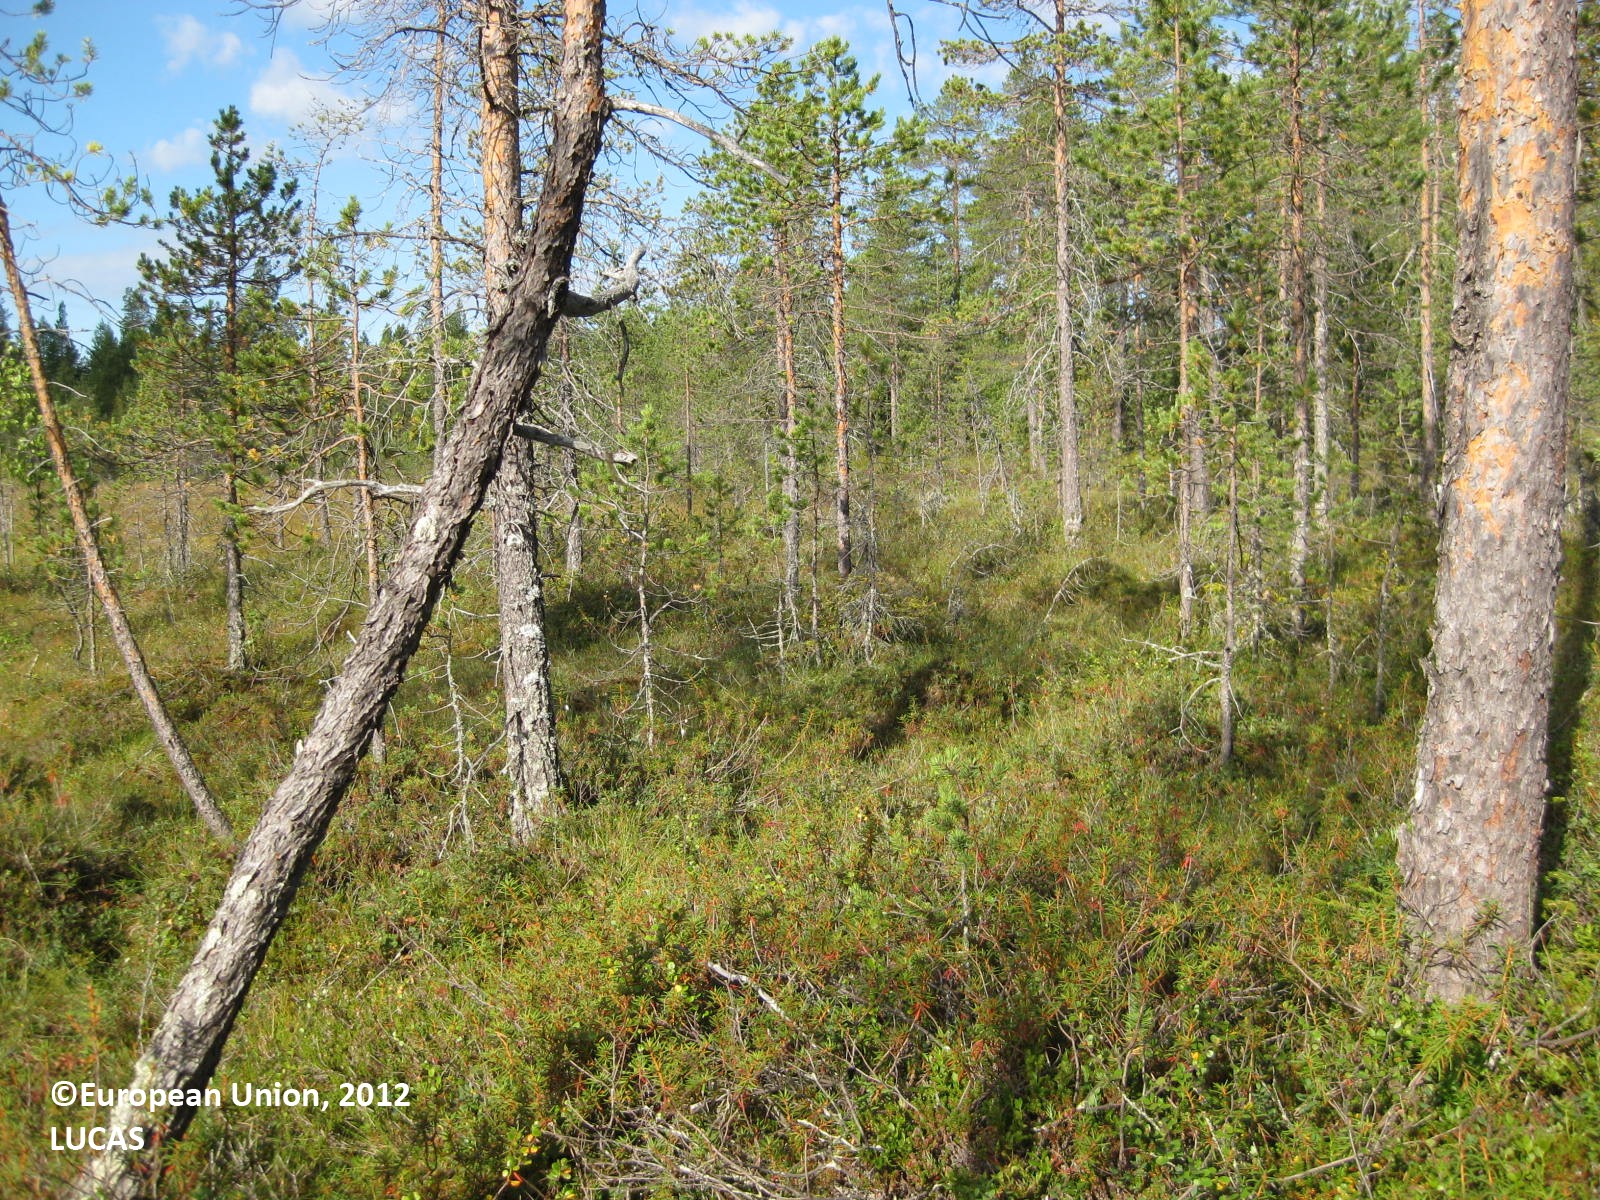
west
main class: Woodland
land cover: Pine dominated coniferous woodland
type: boreal forest
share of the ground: 50 - 75 %
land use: Forestry
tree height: > 5 m
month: August
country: FI
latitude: 66.5432
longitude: 29.0528
